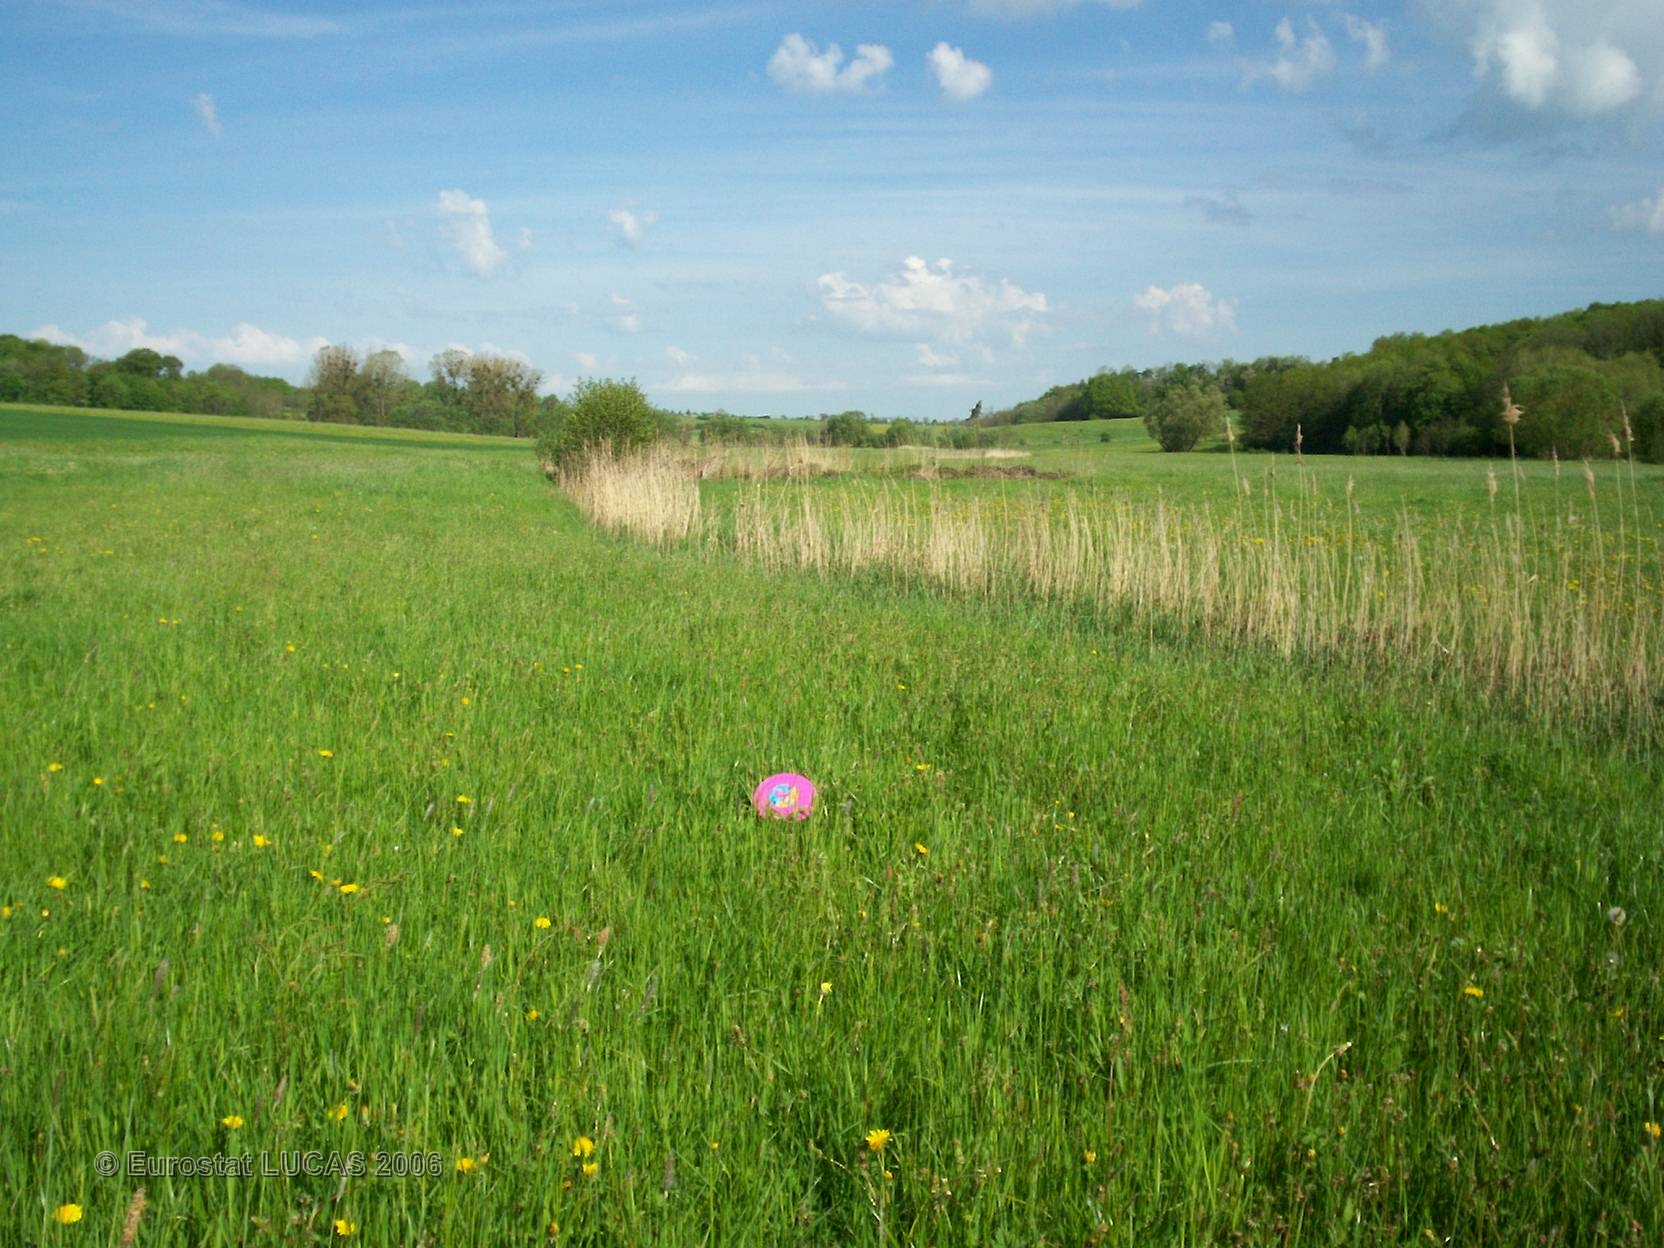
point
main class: Grassland
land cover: Grassland without tree/shrub cover
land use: Agriculture (excluding fallow land and kitchen gardens)
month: May
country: FR
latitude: 48.2931
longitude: 5.9430
